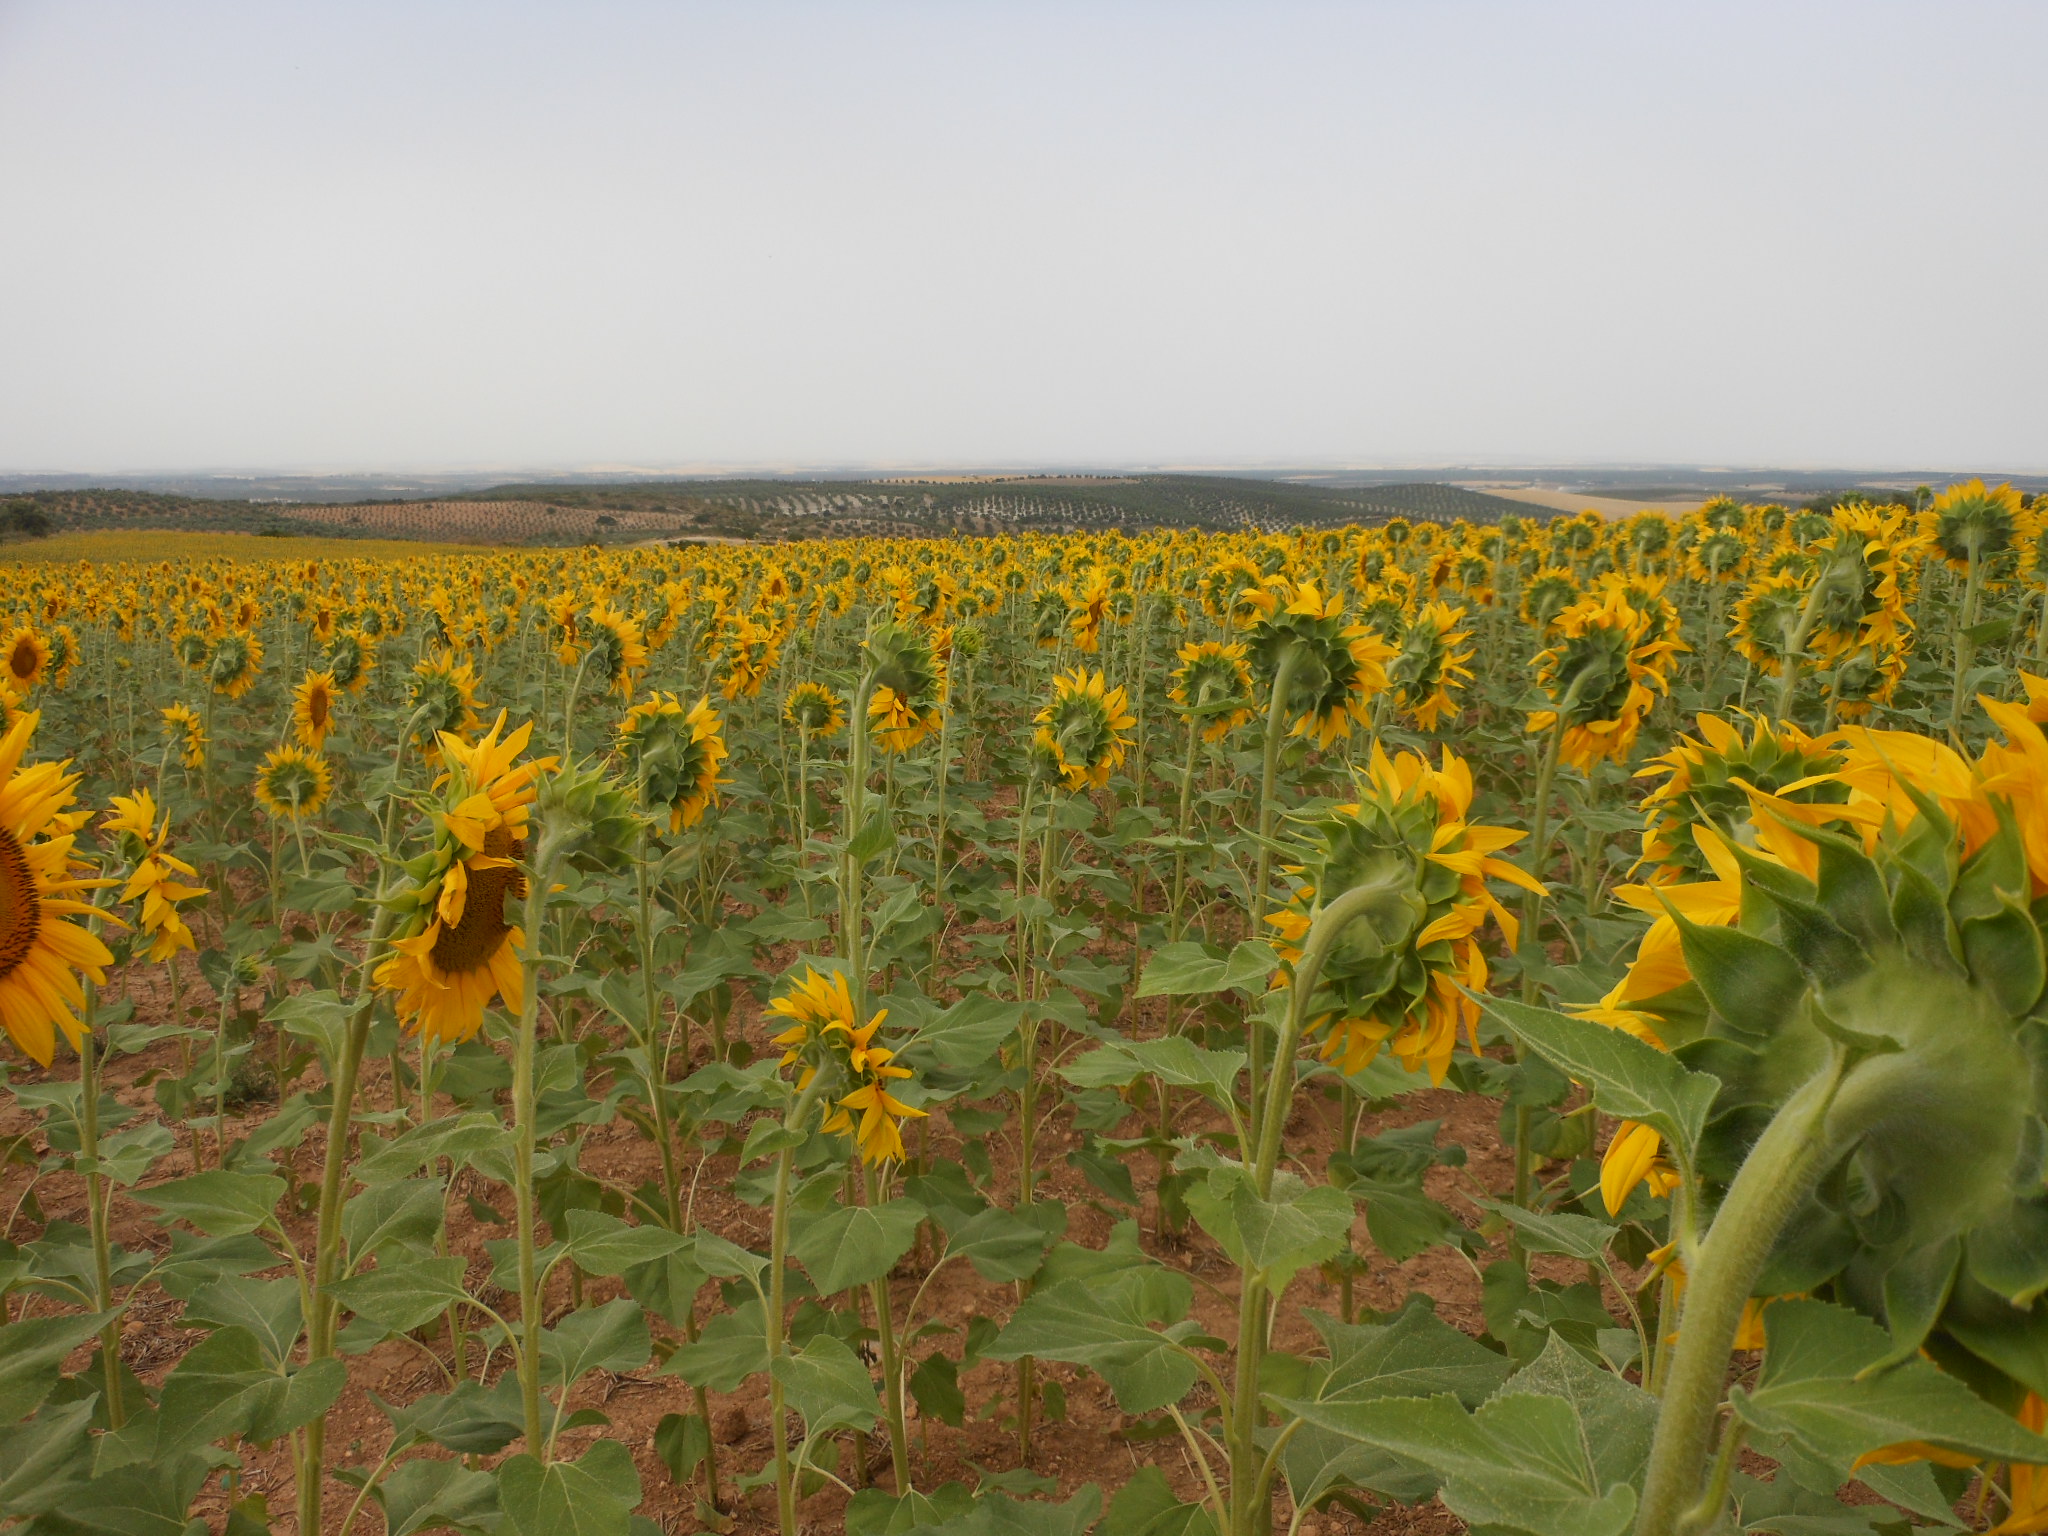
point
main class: Cropland
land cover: Sunflower
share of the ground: > 75 %
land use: Agriculture (excluding fallow land and kitchen gardens)
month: June
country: ES
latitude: 37.1765
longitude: -5.3388
